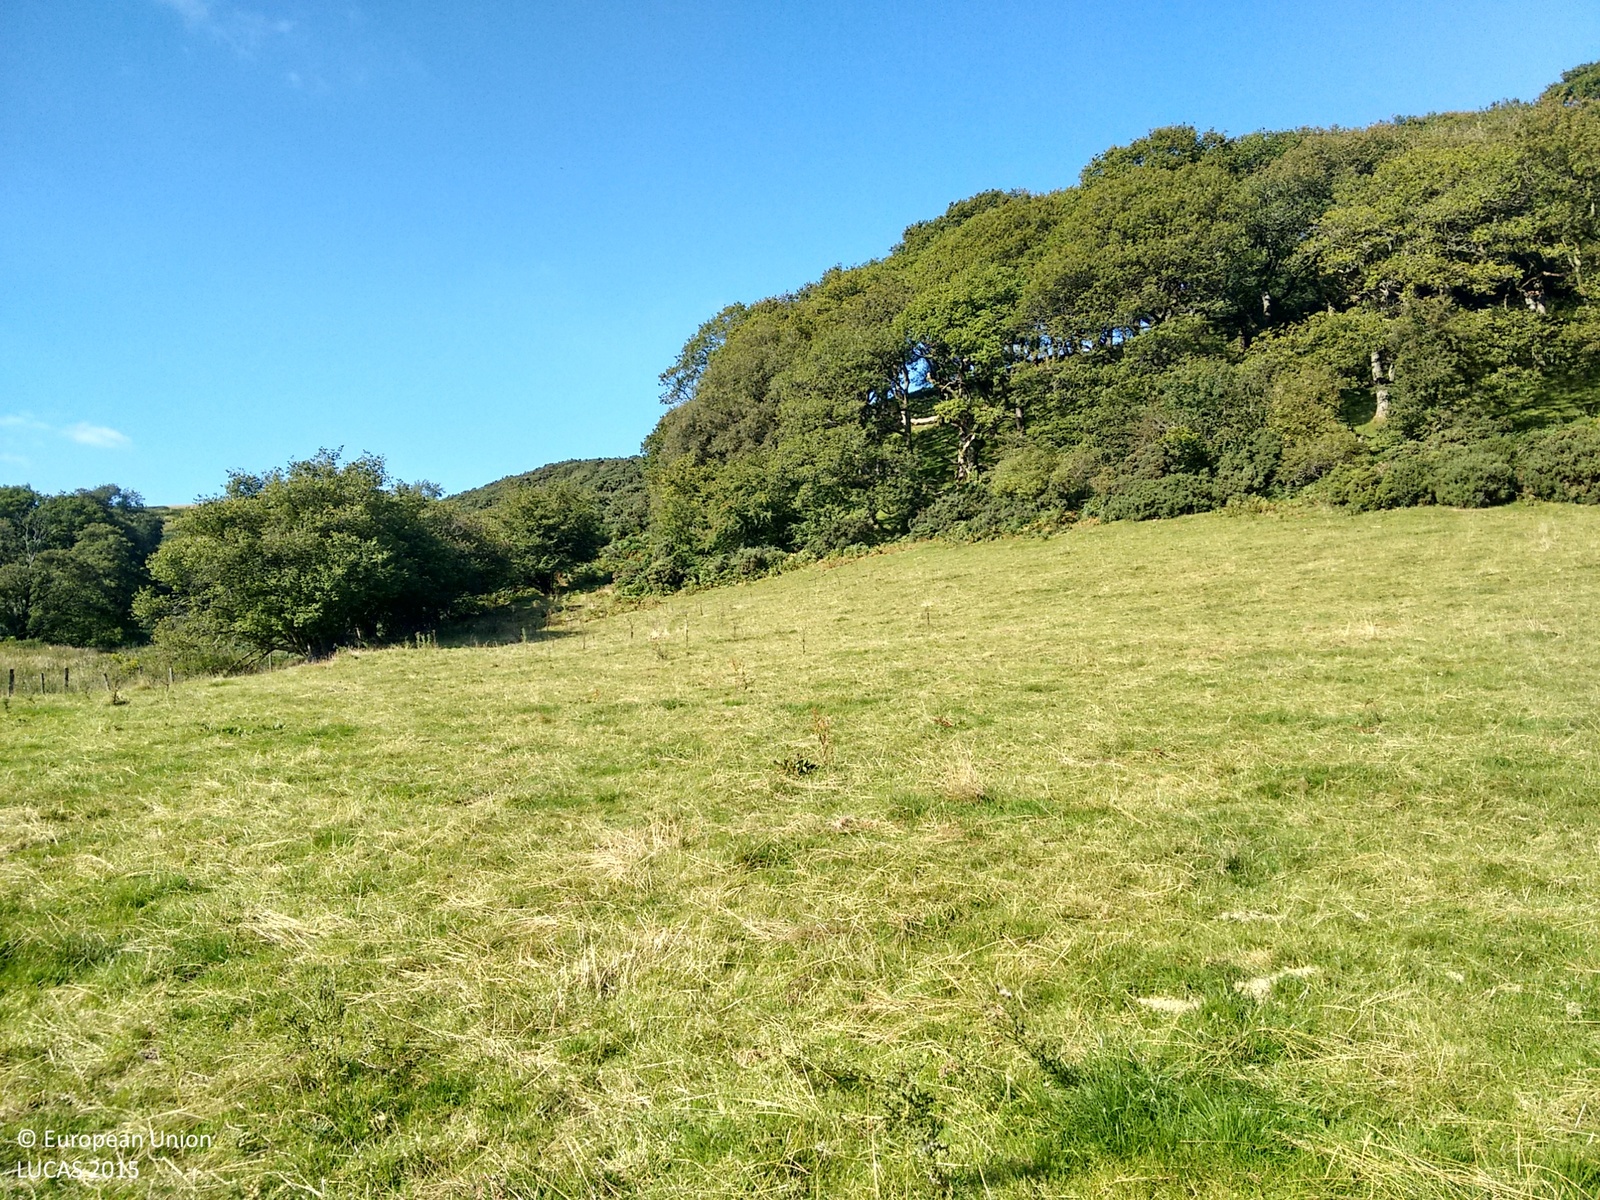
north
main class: Grassland
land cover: Grassland without tree/shrub cover
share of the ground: > 75 %
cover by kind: herbaceous plants 100 %
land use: Agriculture (excluding fallow land and kitchen gardens)
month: September
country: GB
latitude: 52.0304
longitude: -3.4197
